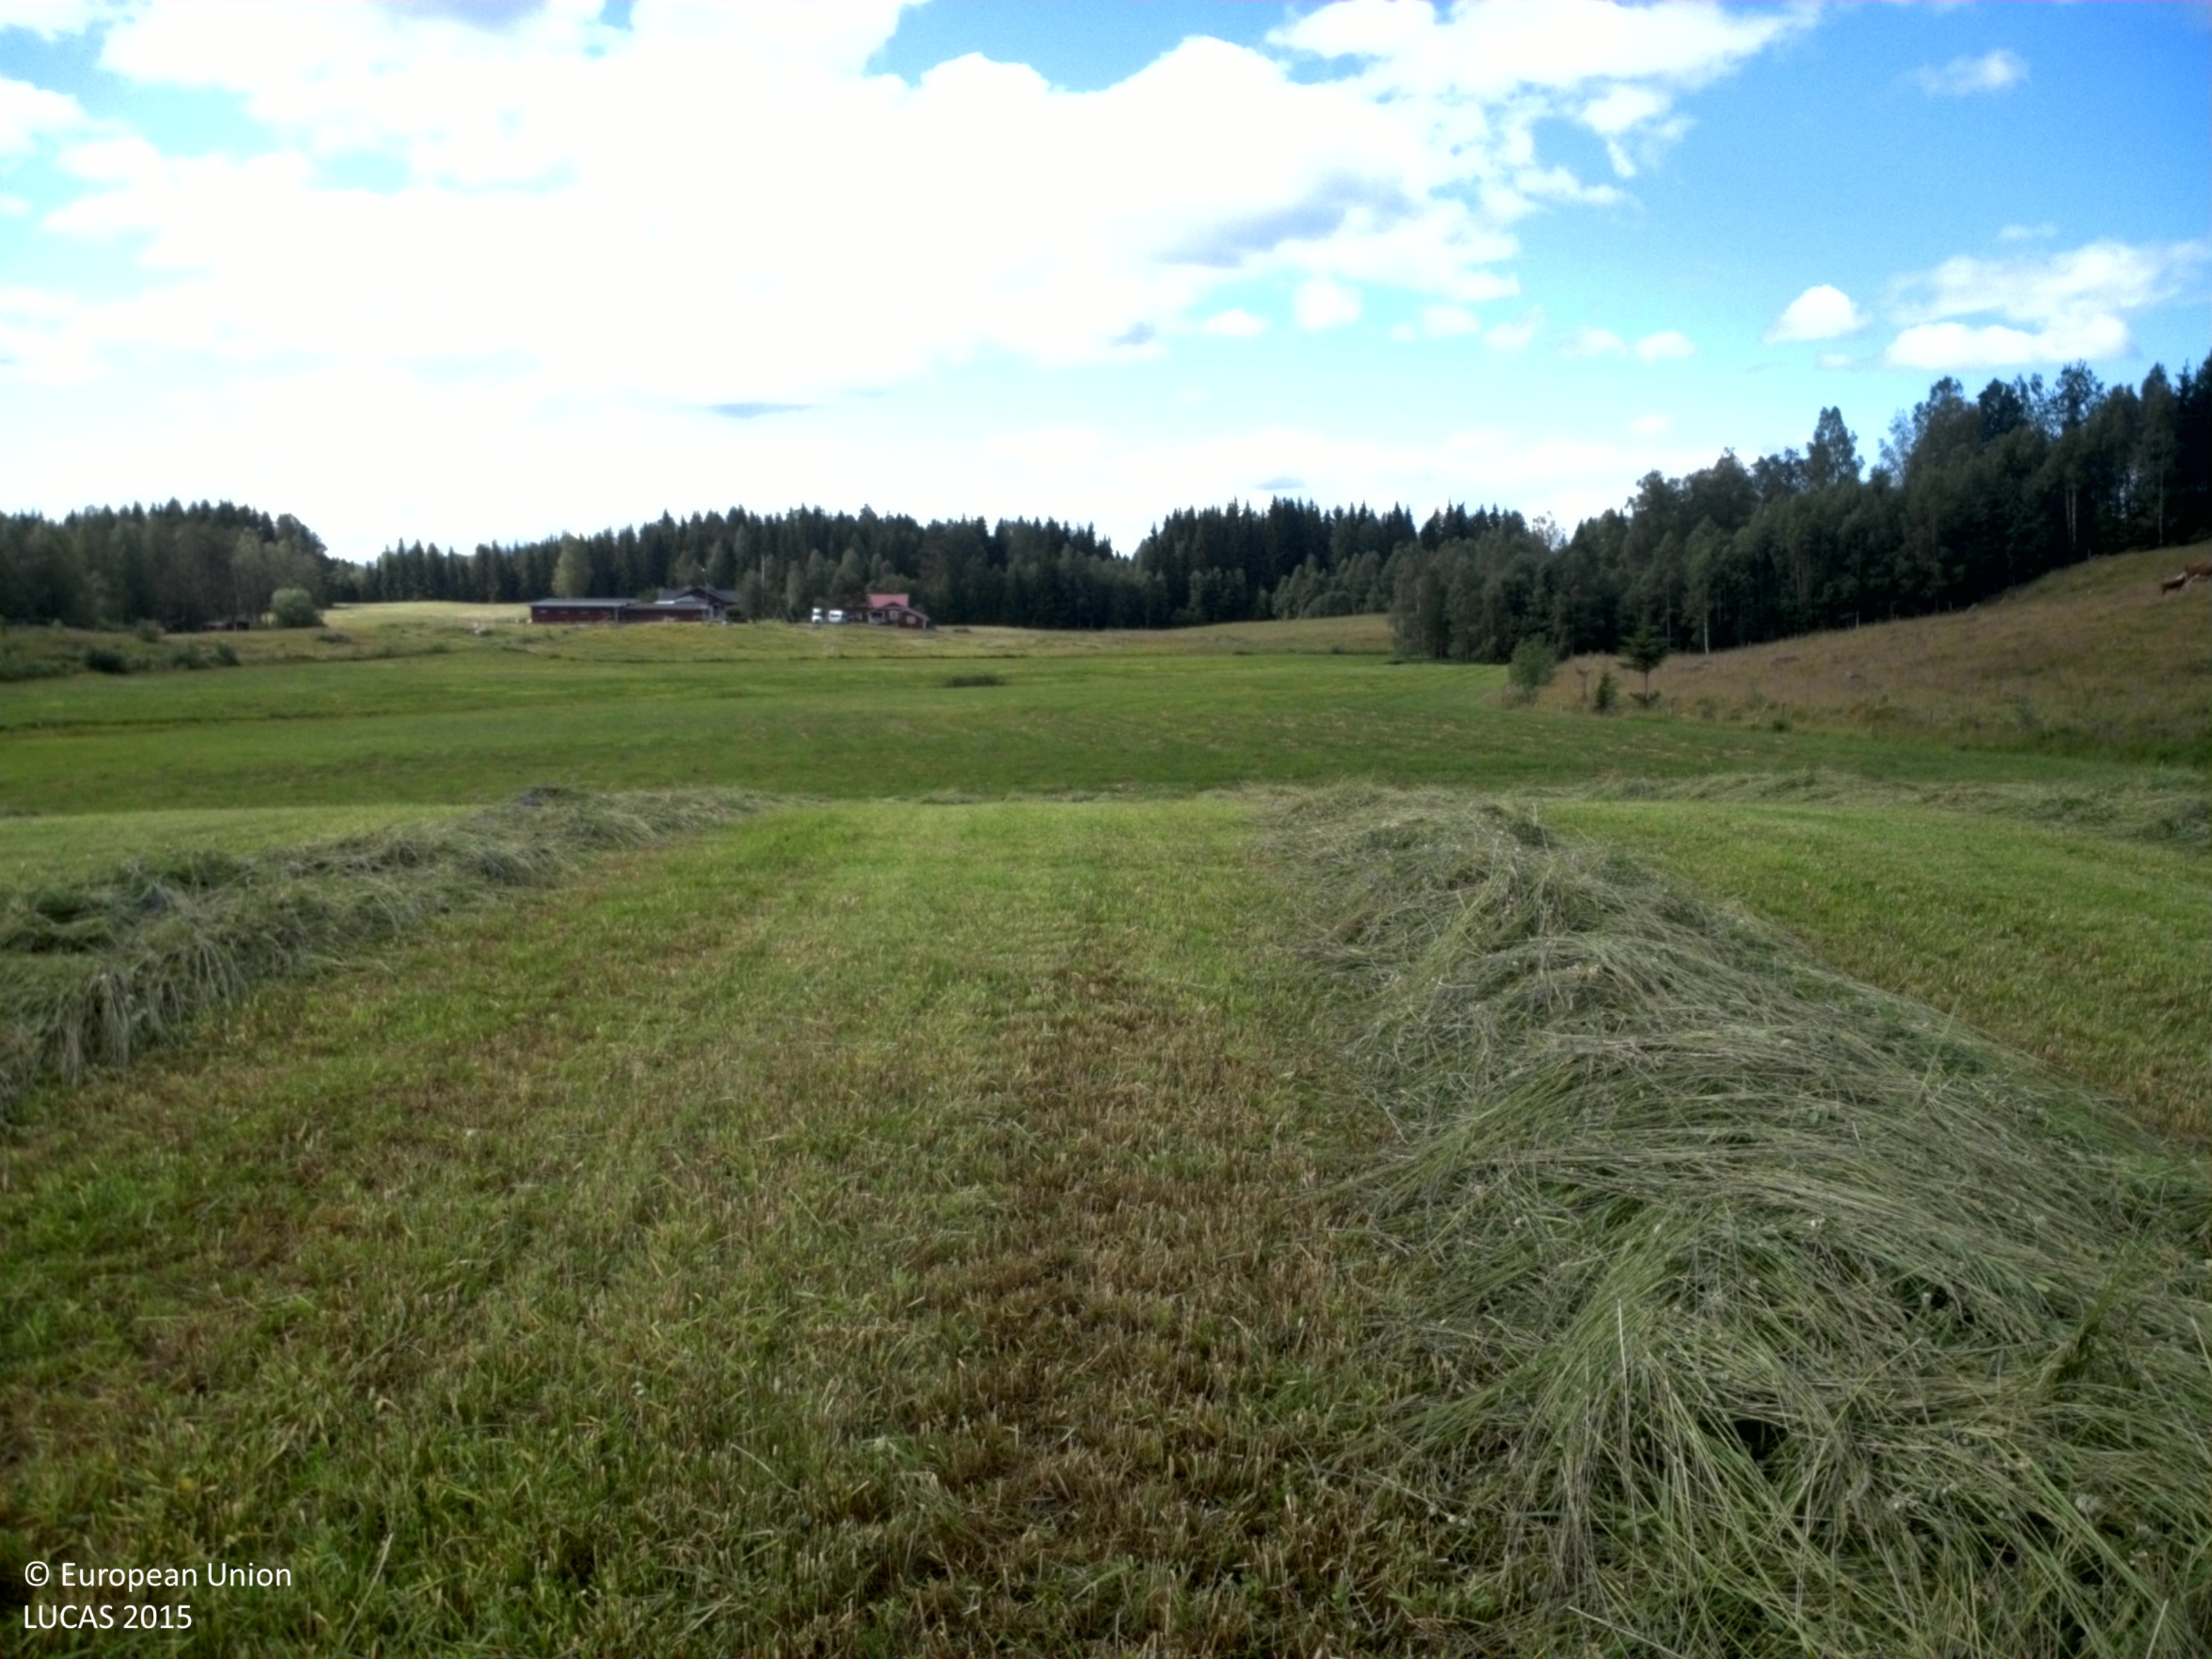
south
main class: Cropland
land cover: Other leguminous and mixtures for fodder
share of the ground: > 75 %
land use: Agriculture (excluding fallow land and kitchen gardens)
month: July
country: SE
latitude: 59.8534
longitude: 12.4389
